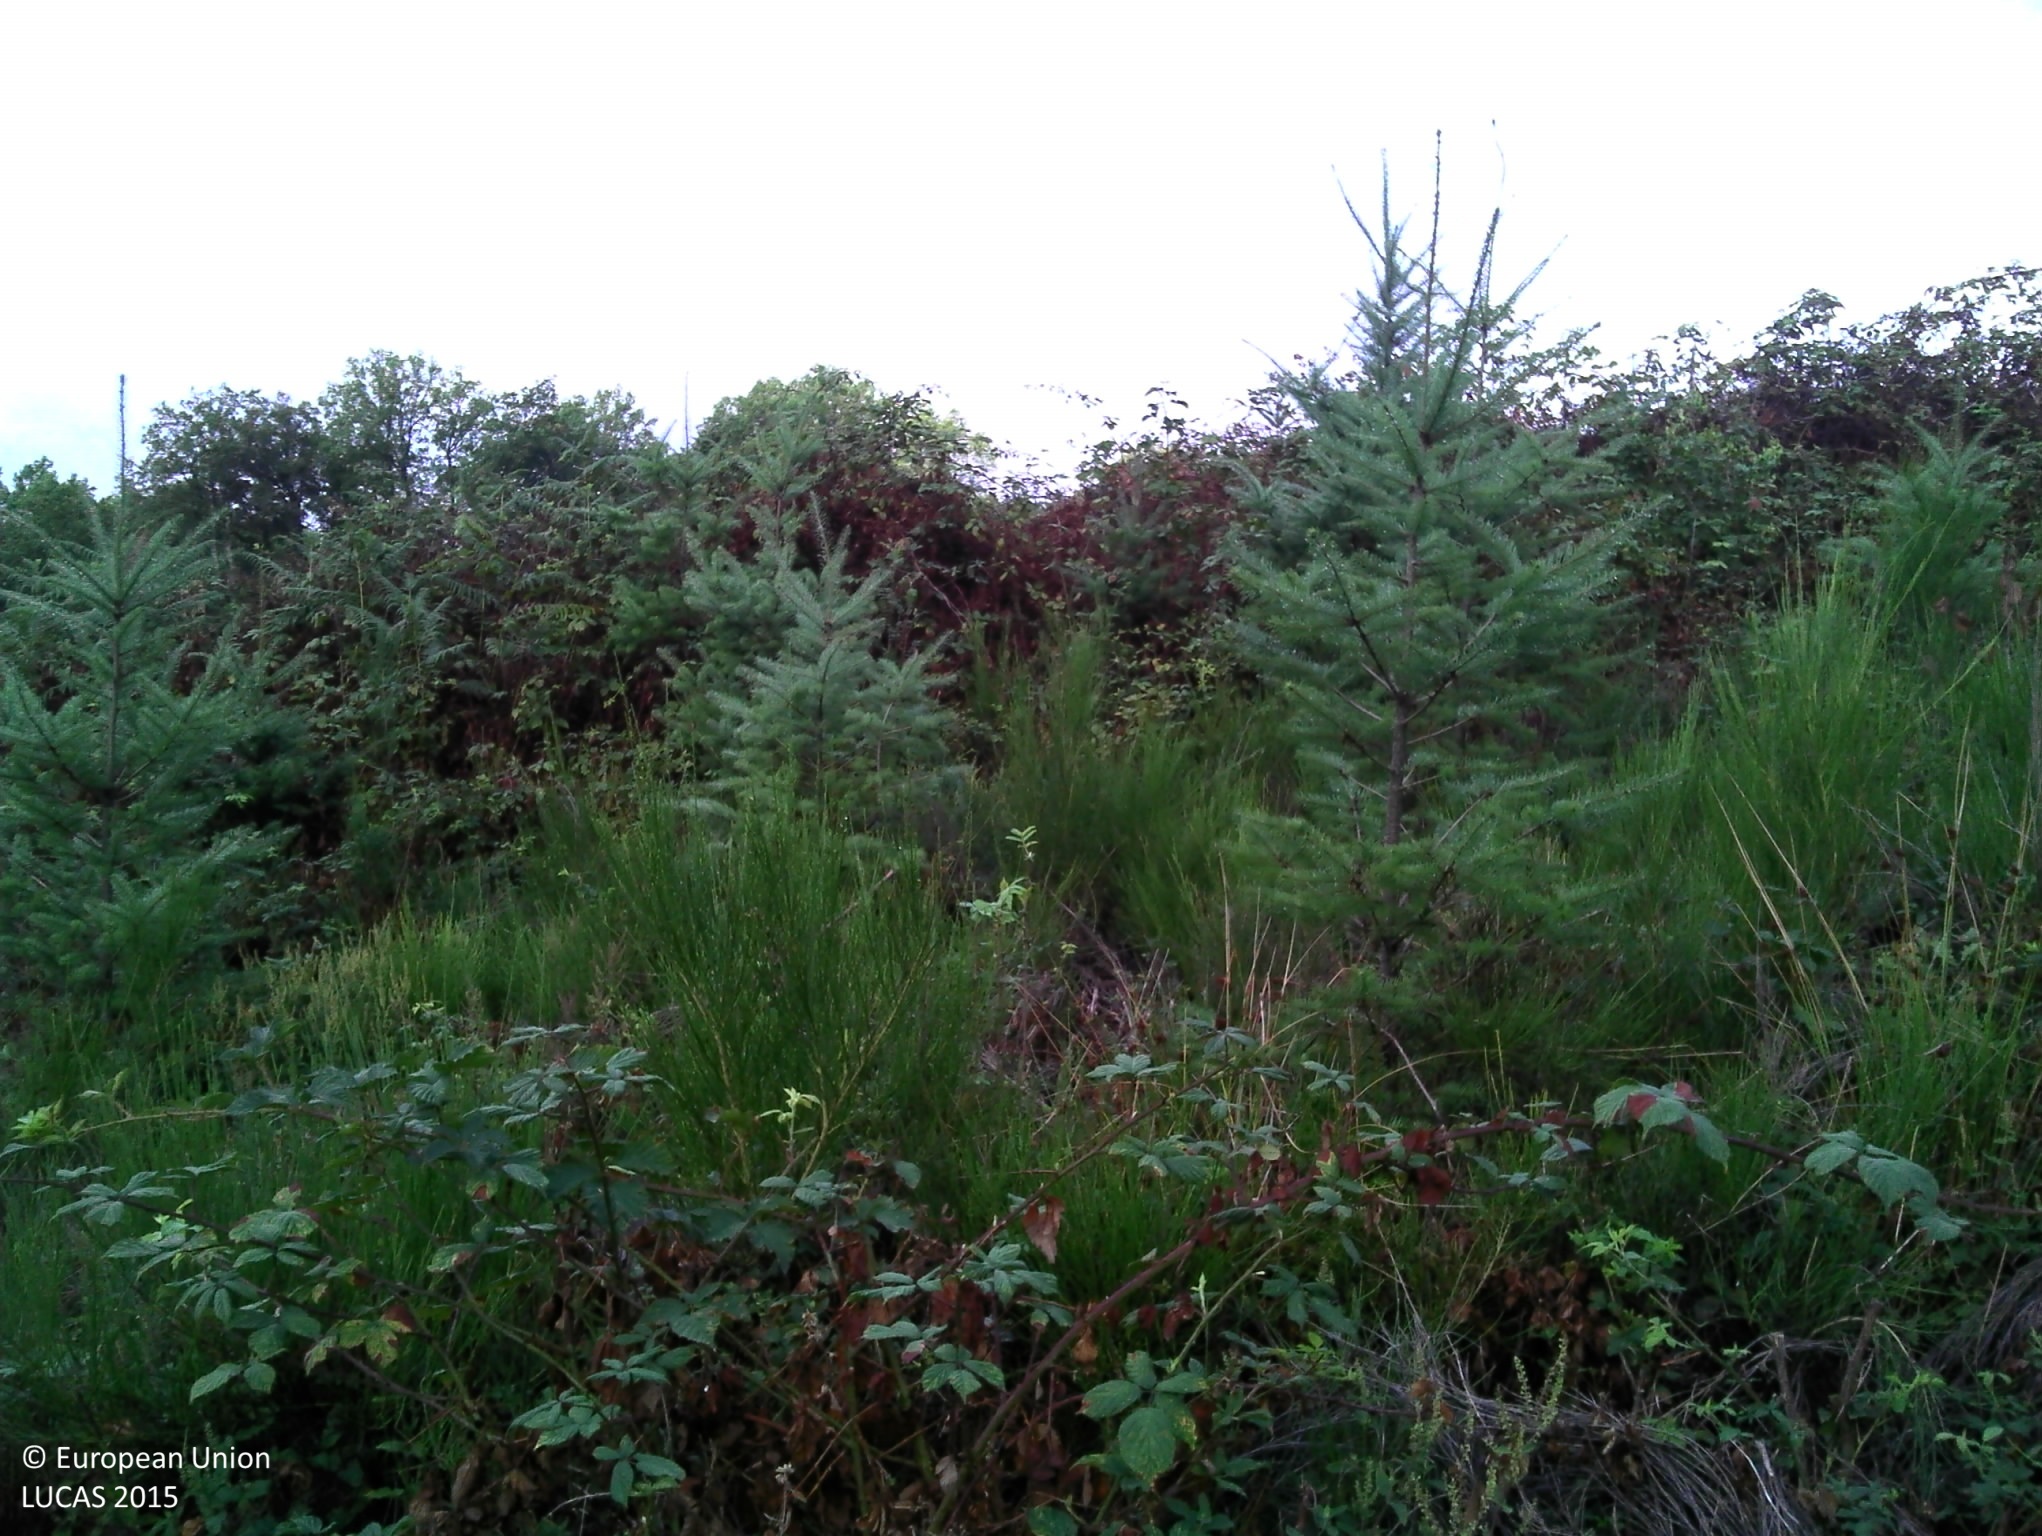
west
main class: Shrubland
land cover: Shrubland with sparse tree cover
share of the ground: > 75 %
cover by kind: shrubs 95 %, coniferous forest trees 5 %
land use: Semi-natural and natural areas not in use
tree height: < 5 m
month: August
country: FR
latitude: 45.4943
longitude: 1.8185
